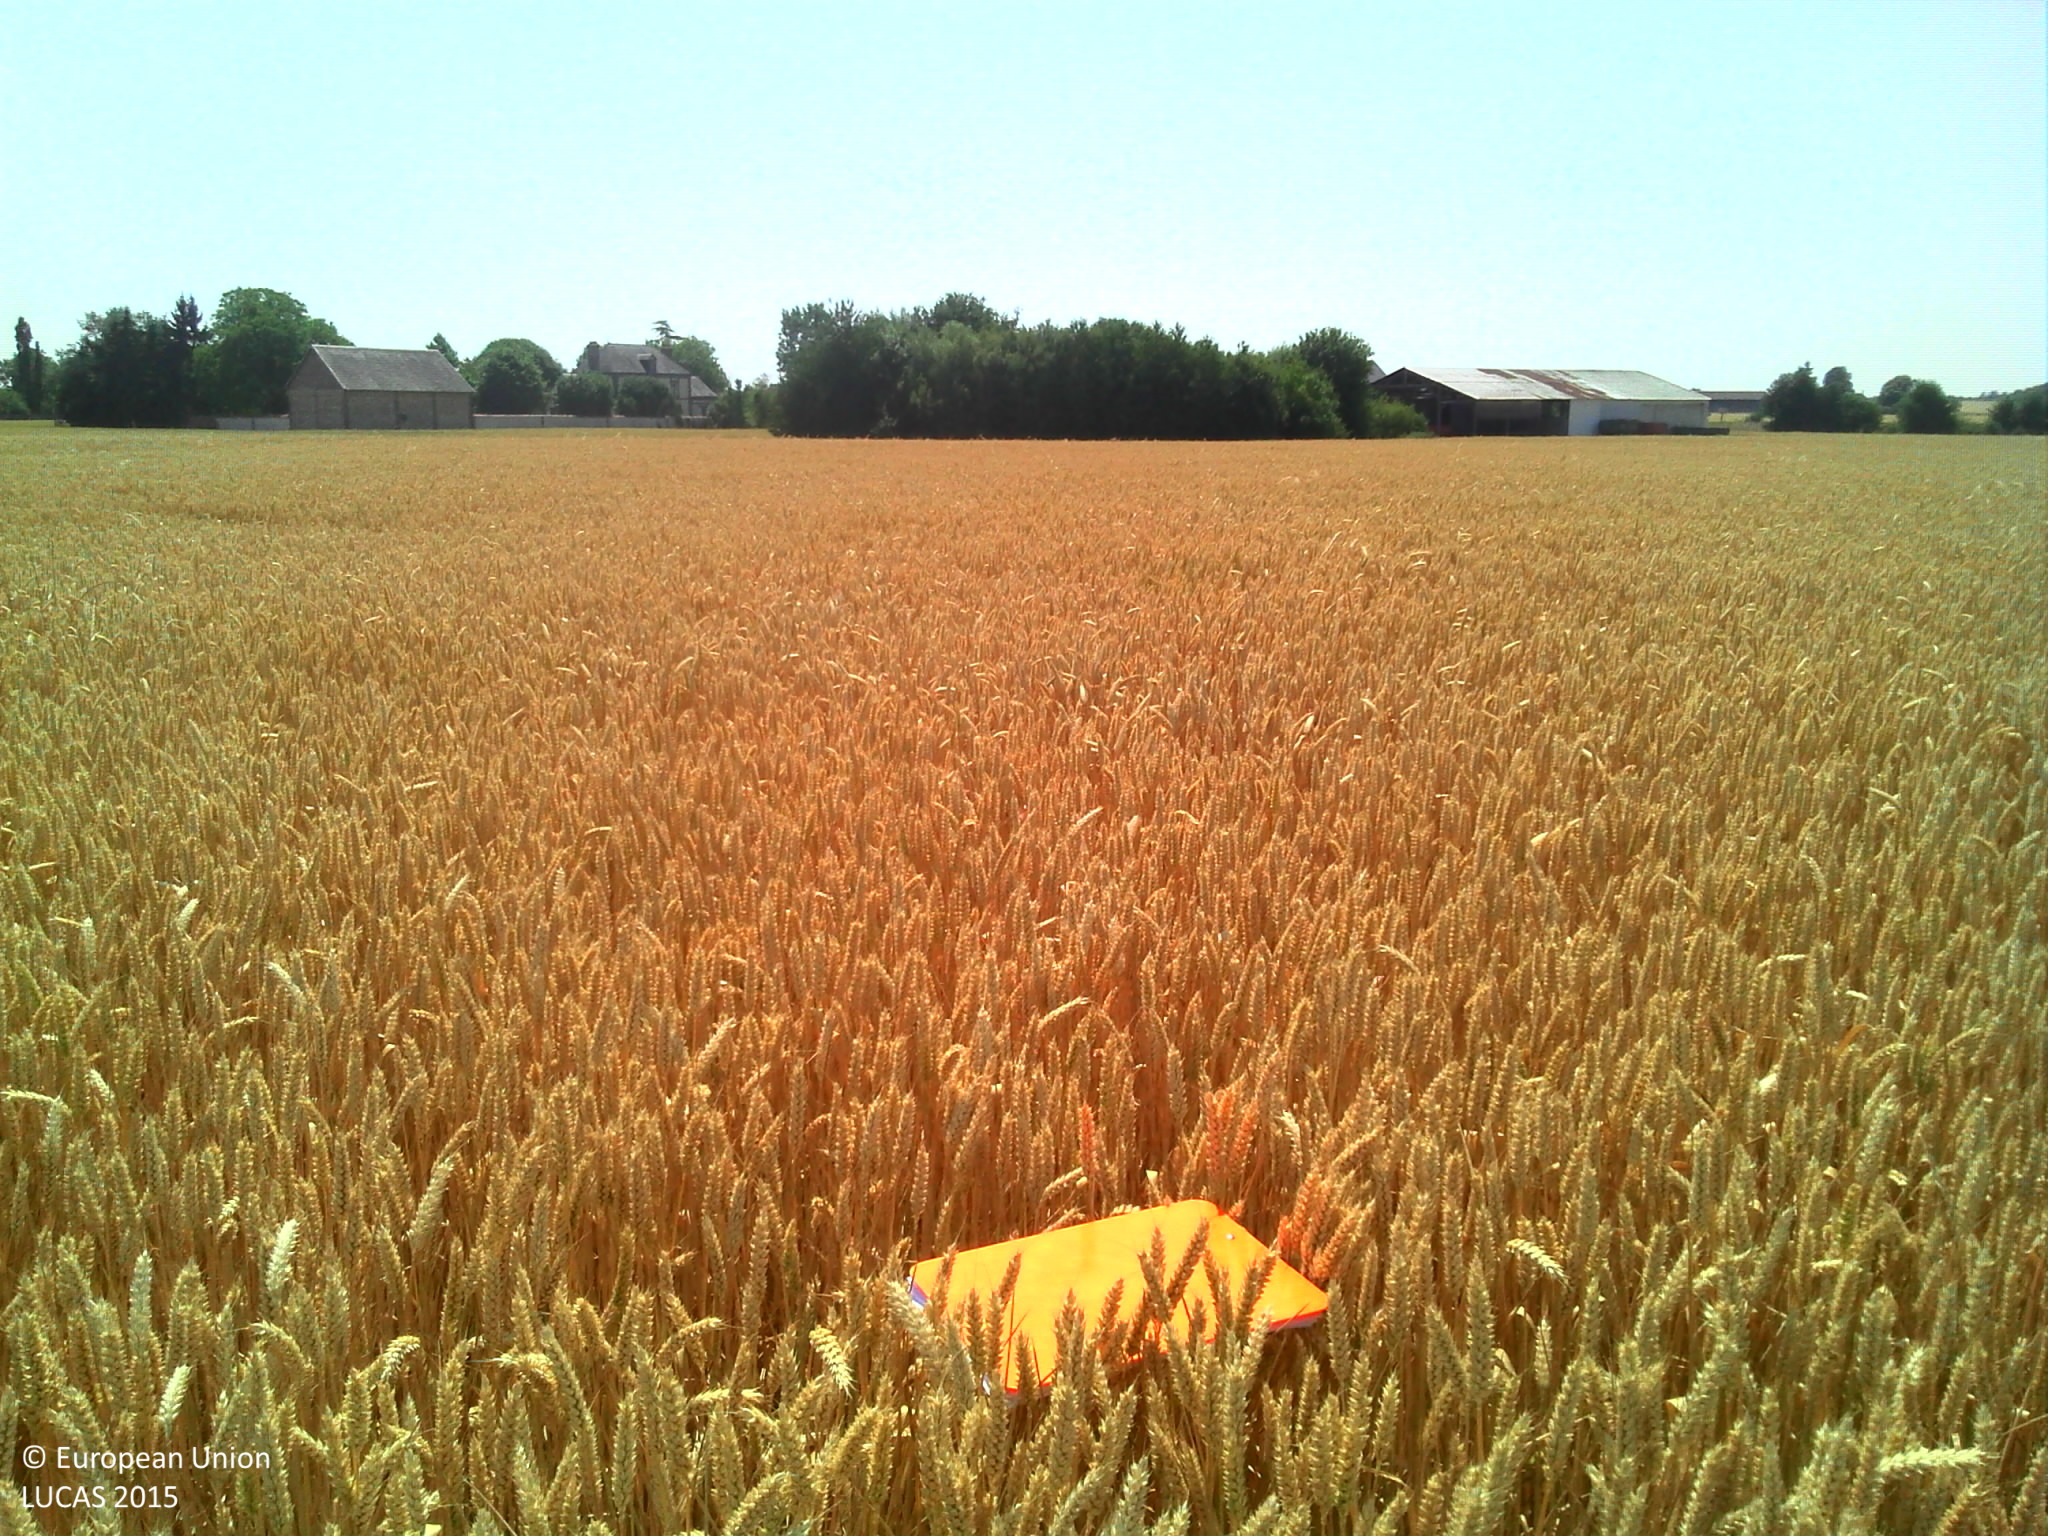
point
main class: Cropland
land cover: Common wheat
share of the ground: > 75 %
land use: Agriculture (excluding fallow land and kitchen gardens)
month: July
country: FR
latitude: 48.9411
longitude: 1.2289
